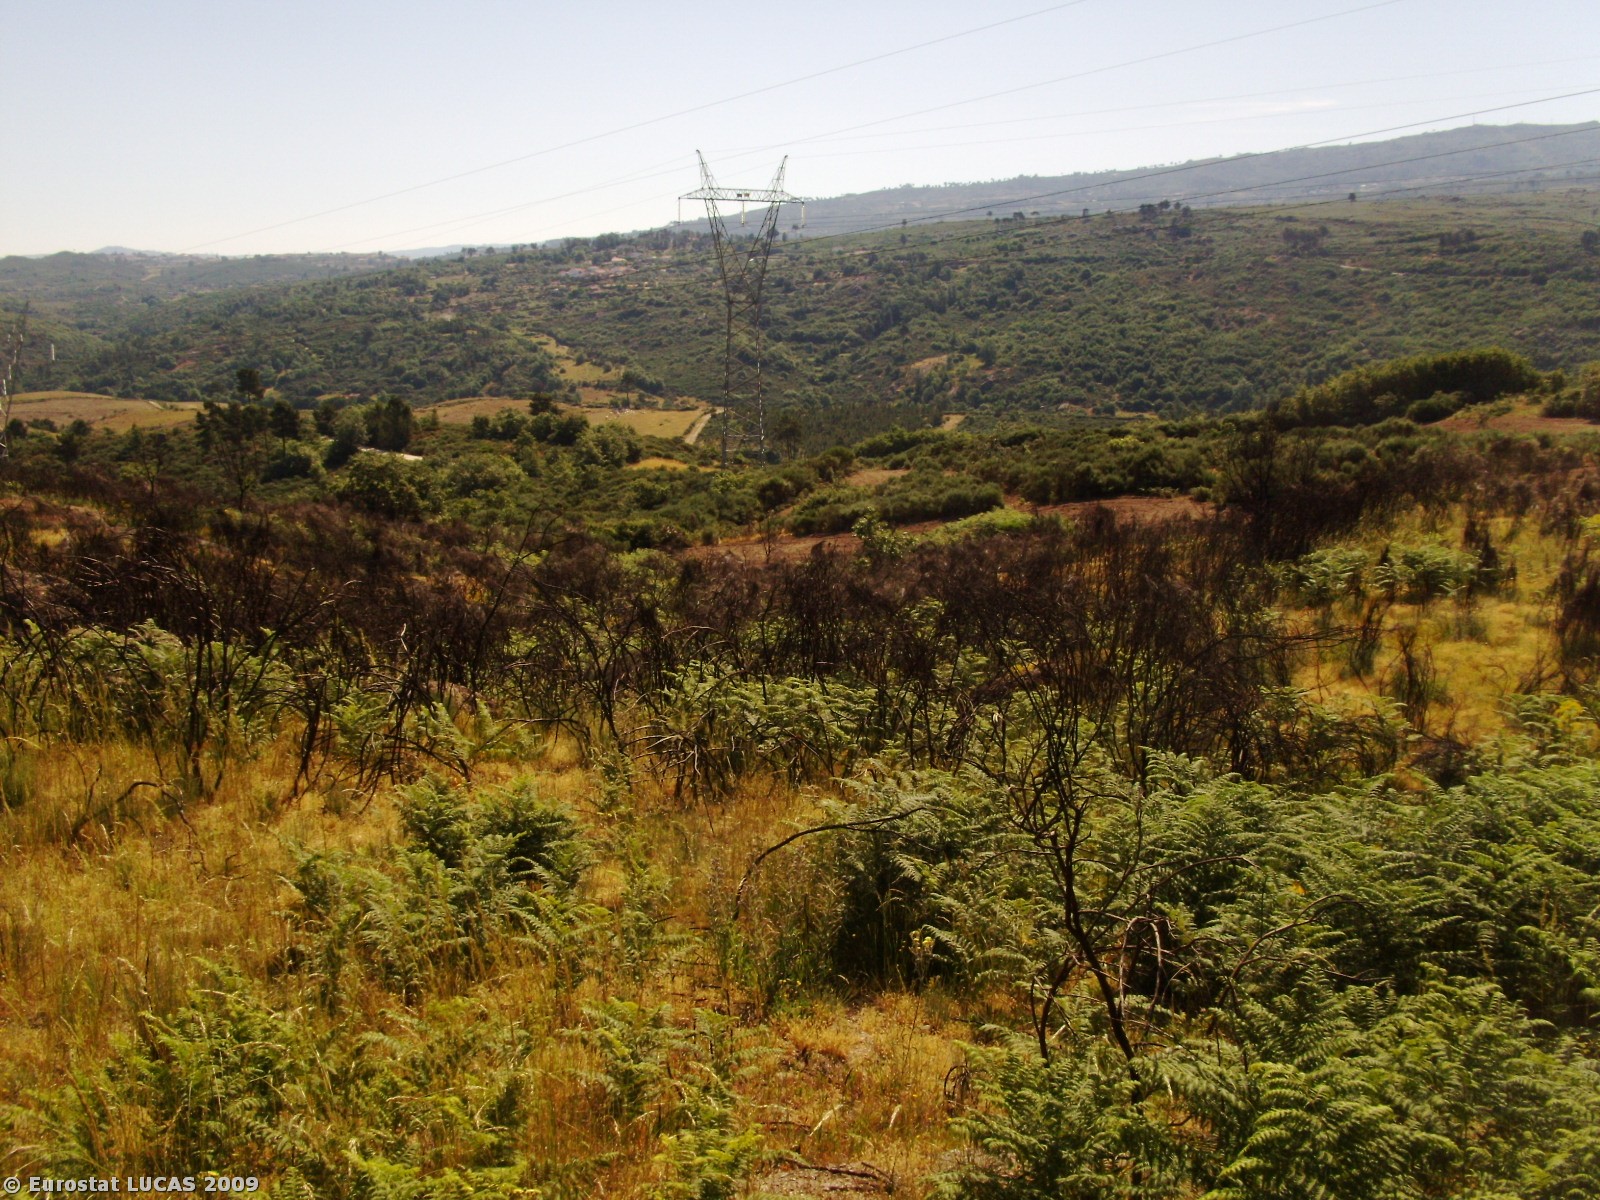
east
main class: Shrubland
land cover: Shrubland with sparse tree cover
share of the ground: > 75 %
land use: Fallow land
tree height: > 5 m
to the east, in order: Shrubland with sparse tree cover; Maize; Shrubland with sparse tree cover; Electric lines; Maize; Electric lines; Shruby margins; Tracks; Shruby margins; Rye
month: June
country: PT
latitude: 40.6090
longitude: -7.4499
